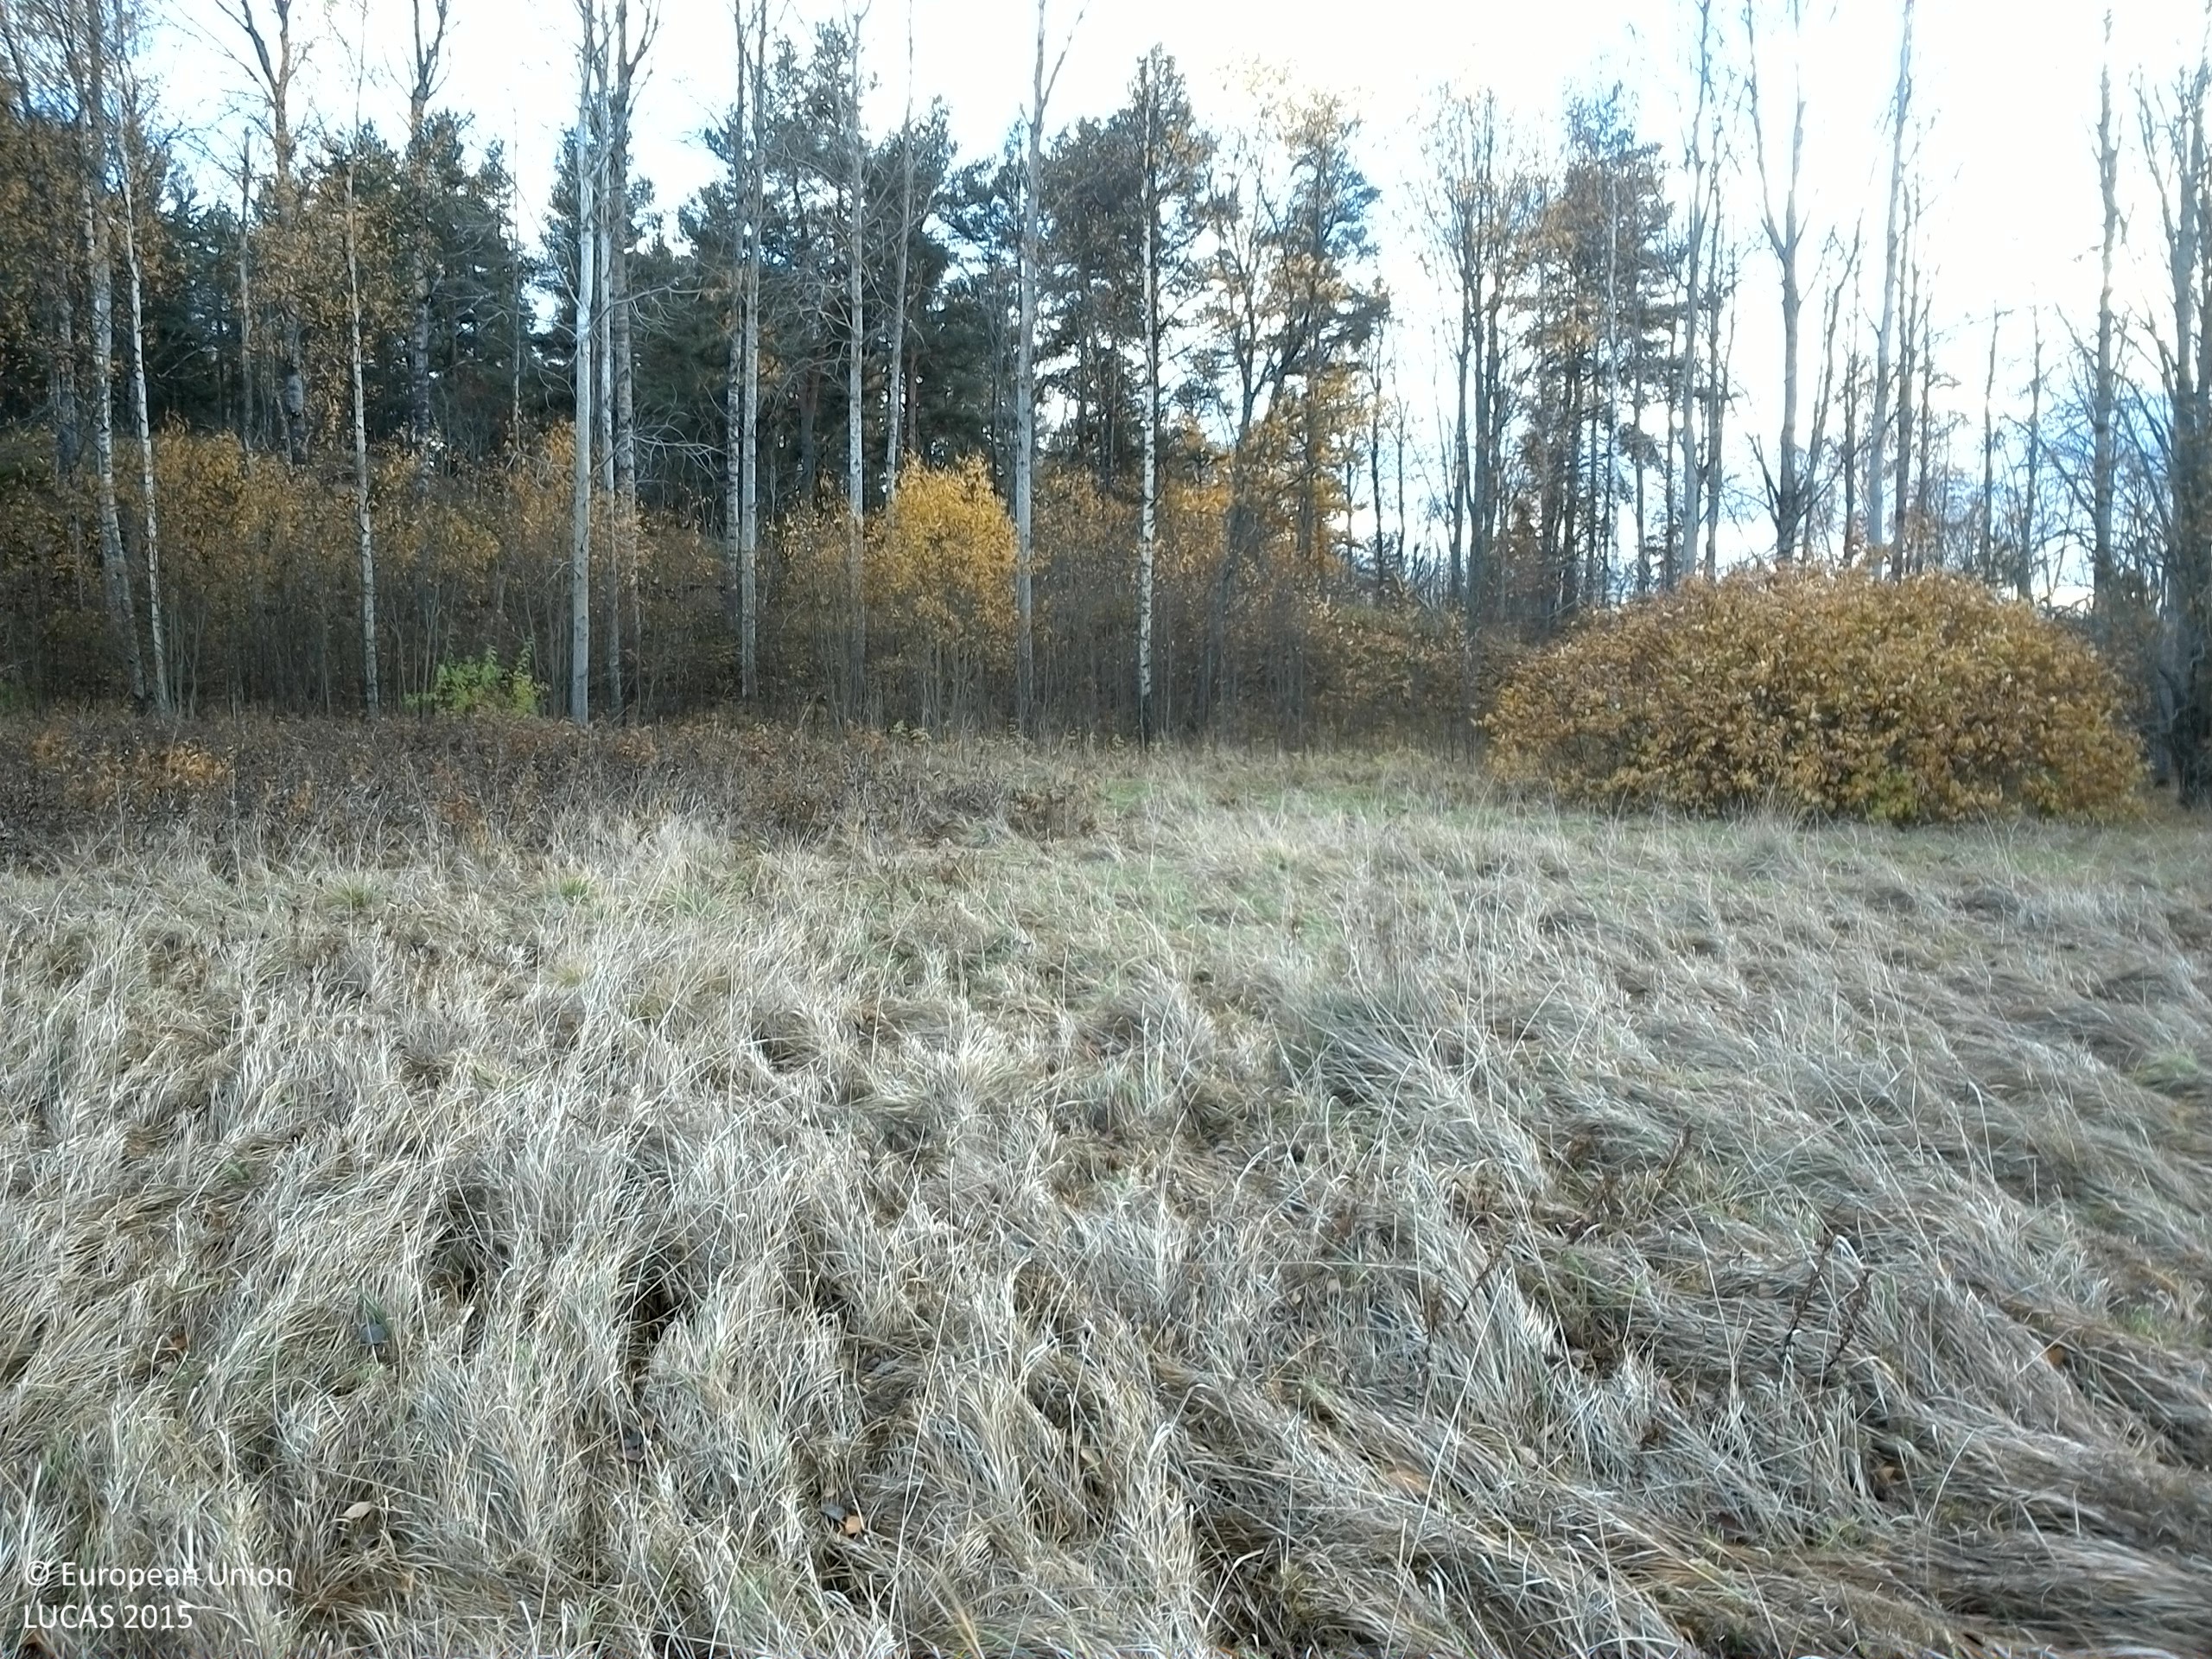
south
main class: Grassland
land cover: Grassland with sparse tree/shrub cover
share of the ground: > 75 %
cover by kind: herbaceous plants 95 %, coniferous forest trees 5 %
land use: Semi-natural and natural areas not in use
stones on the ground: < 10 %
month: October
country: SE
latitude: 59.3777
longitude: 16.5582
